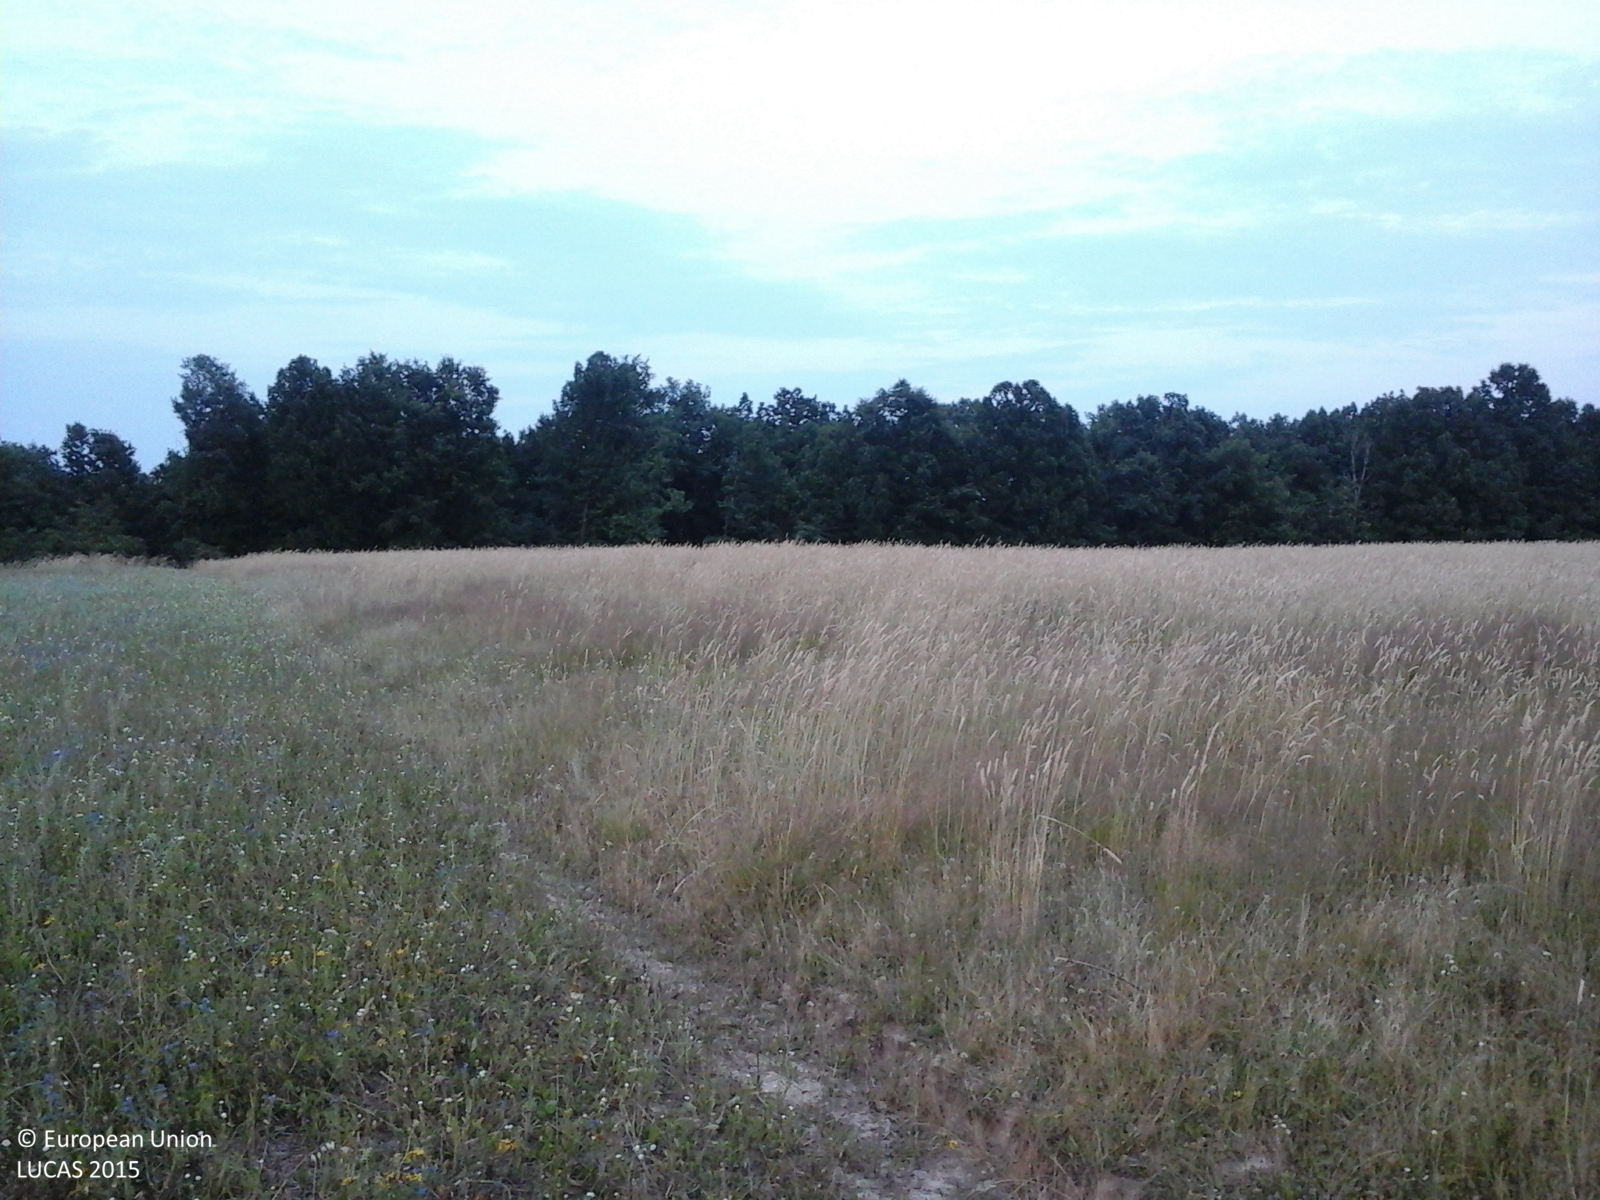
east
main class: Grassland
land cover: Grassland without tree/shrub cover
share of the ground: > 75 %
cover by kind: herbaceous plants 100 %
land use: Agriculture (excluding fallow land and kitchen gardens)
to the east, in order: Grassland without tree/shrub cover; Broadleaved woodland
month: July
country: RO
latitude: 44.9103
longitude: 24.5531
